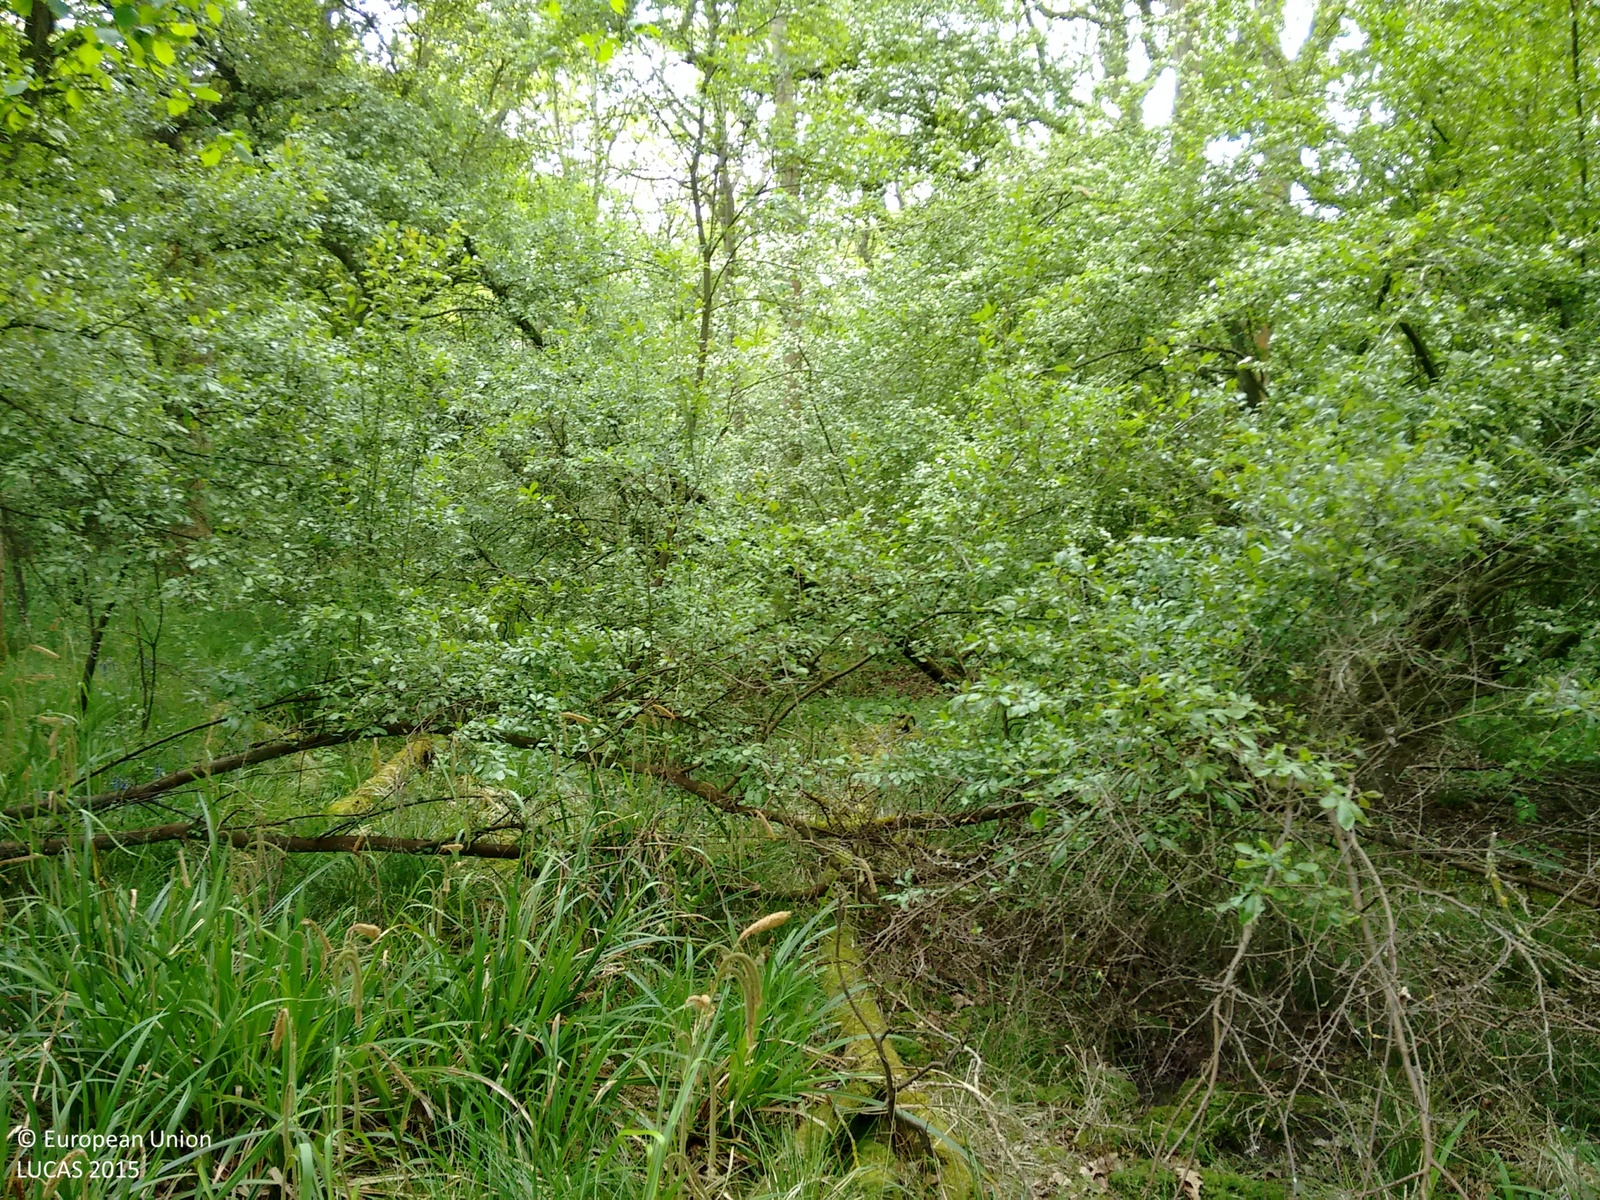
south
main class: Woodland
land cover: Broadleaved woodland
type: mesophytic deciduous forest
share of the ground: > 75 %
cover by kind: broadleaved forest trees 100 %
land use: Community services
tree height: > 5 m
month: May
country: GB
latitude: 52.0660
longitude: -0.5859
